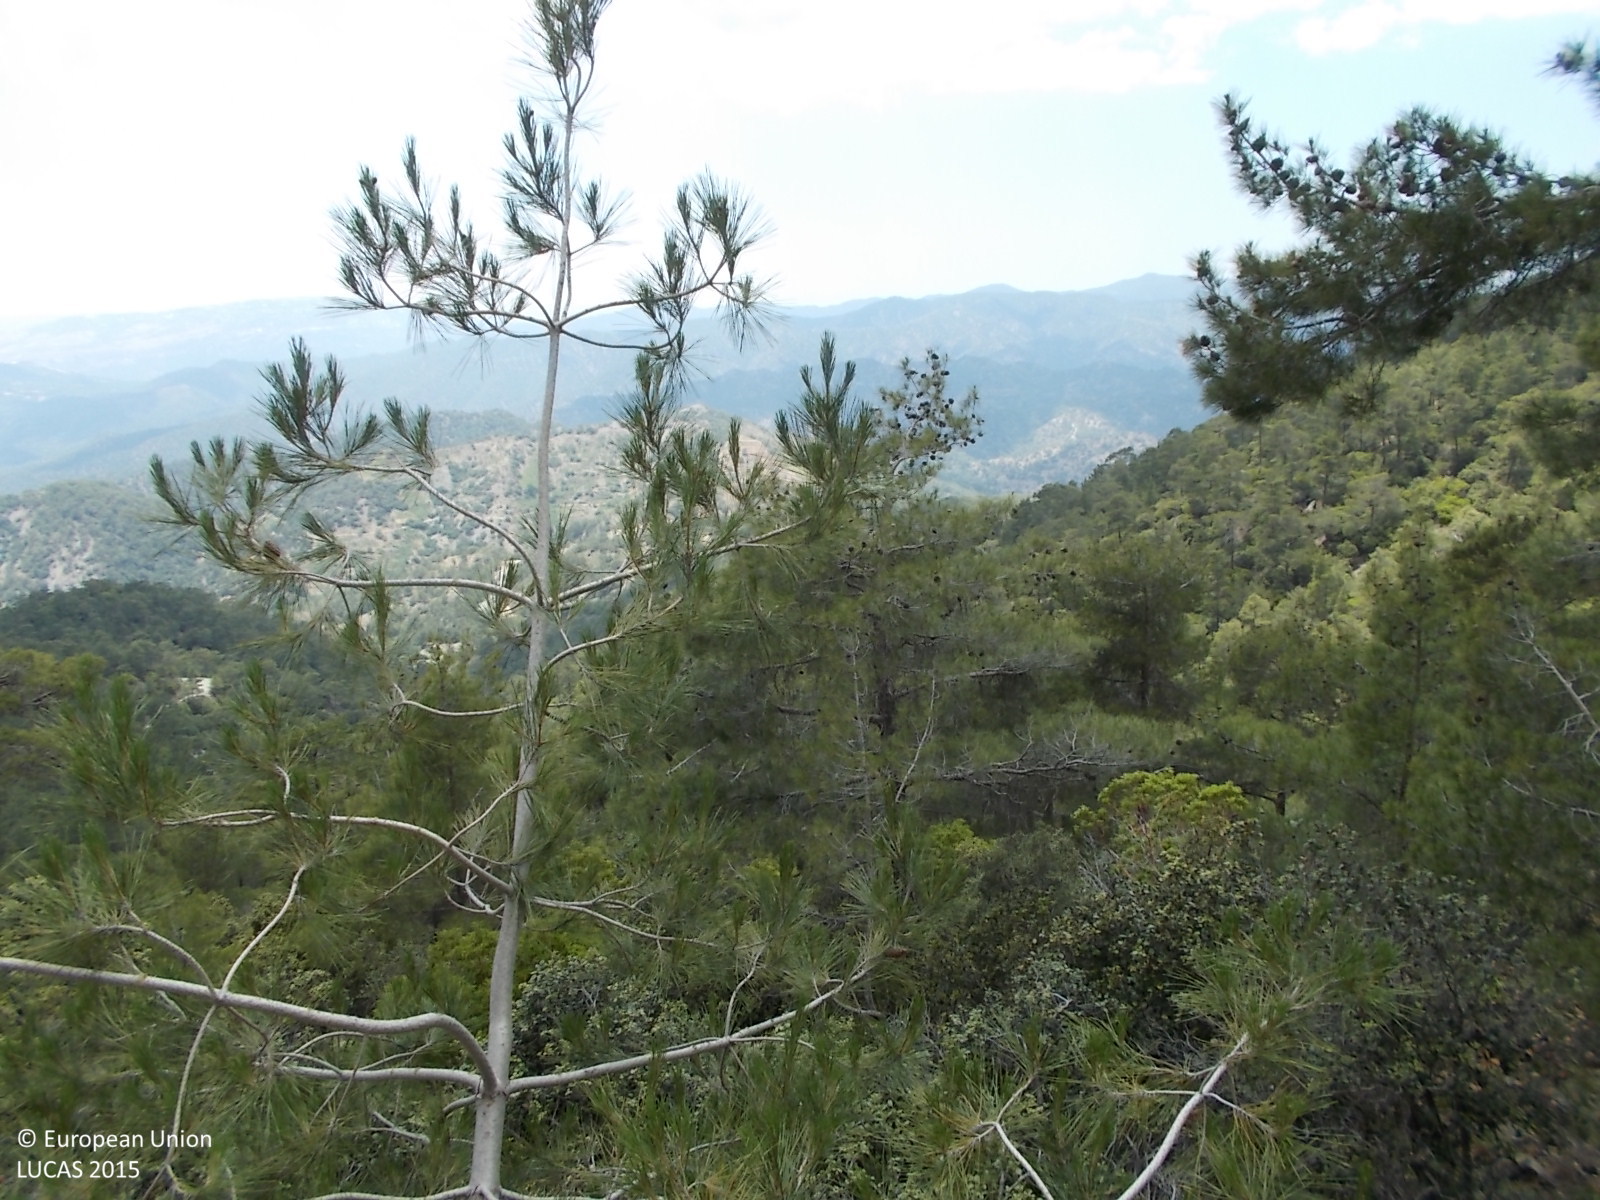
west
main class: Woodland
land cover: Pine dominated coniferous woodland
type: coniferous forest of the mediterranean region
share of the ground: > 75 %
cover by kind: coniferous forest trees 90 %, shrubs 5 %, unconsolidated bare surface 5 %
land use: Forestry
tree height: > 5 m
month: June
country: CY
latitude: 34.9119
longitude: 32.8316
